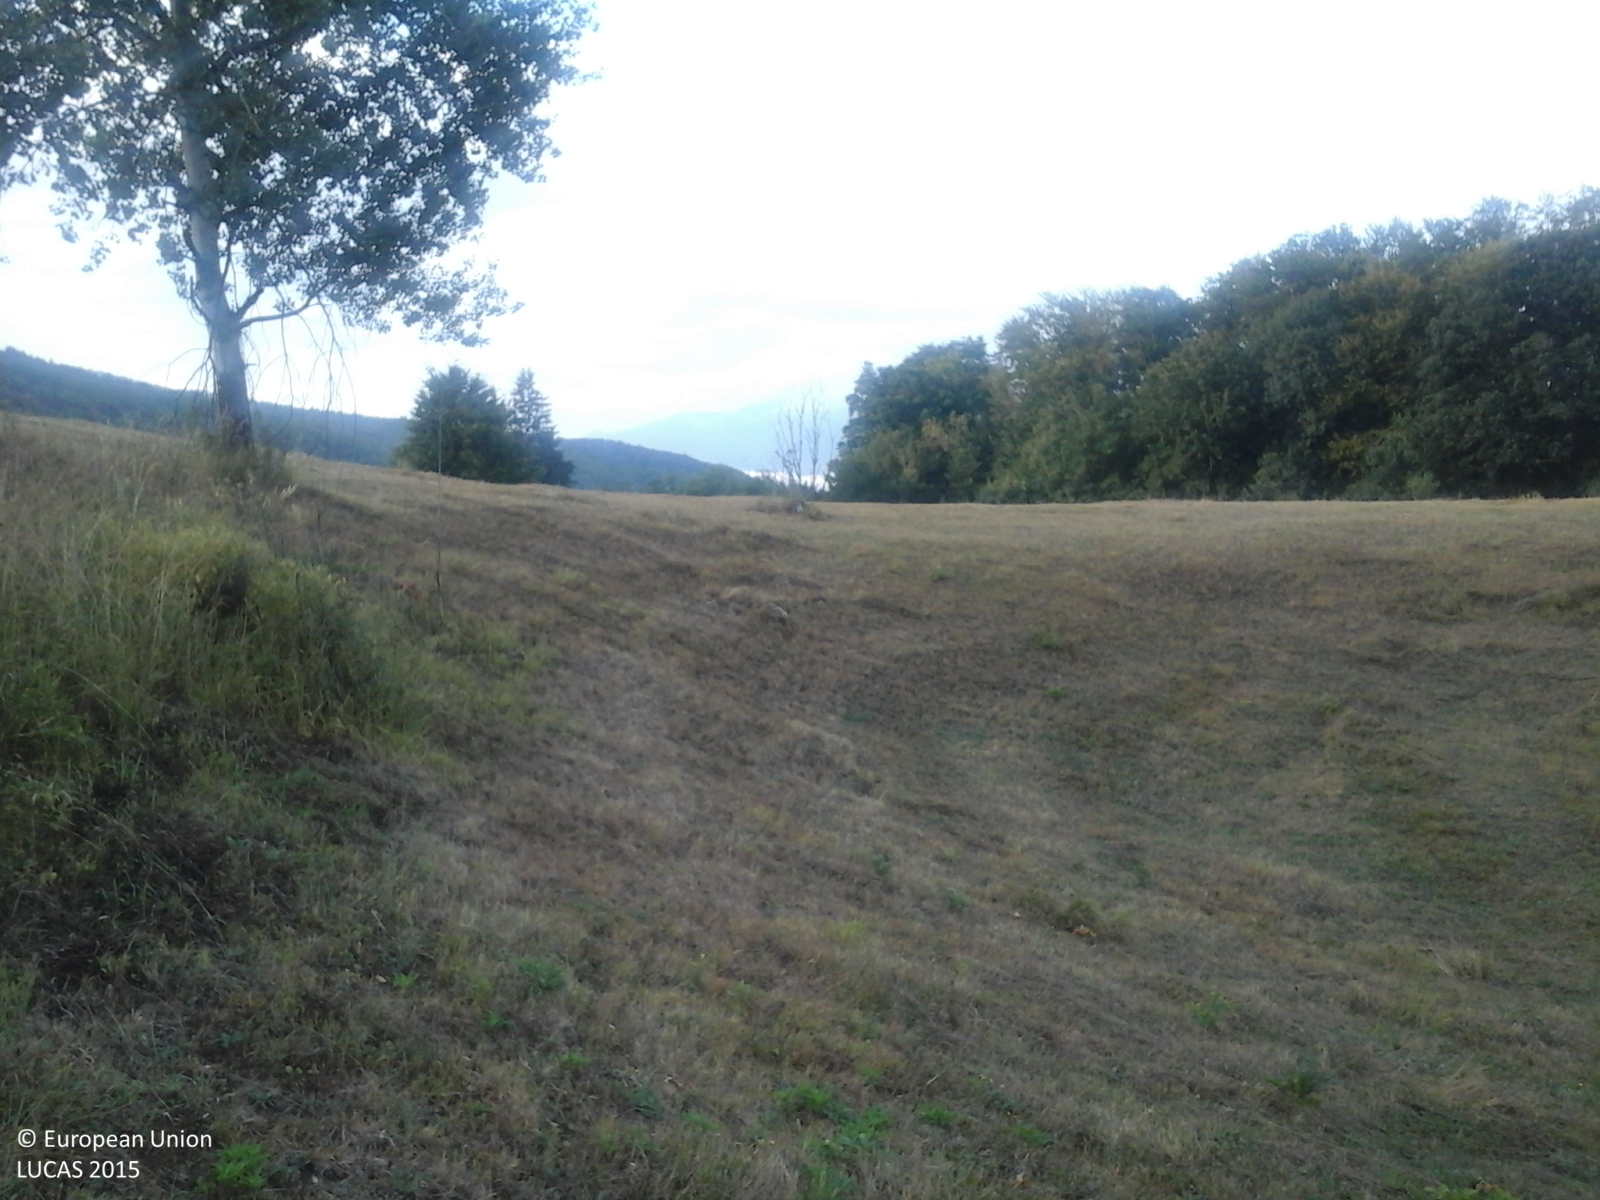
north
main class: Grassland
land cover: Grassland without tree/shrub cover
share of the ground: > 75 %
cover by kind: herbaceous plants 100 %
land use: Agriculture (excluding fallow land and kitchen gardens)
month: August
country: RO
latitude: 44.8419
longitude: 21.7844
